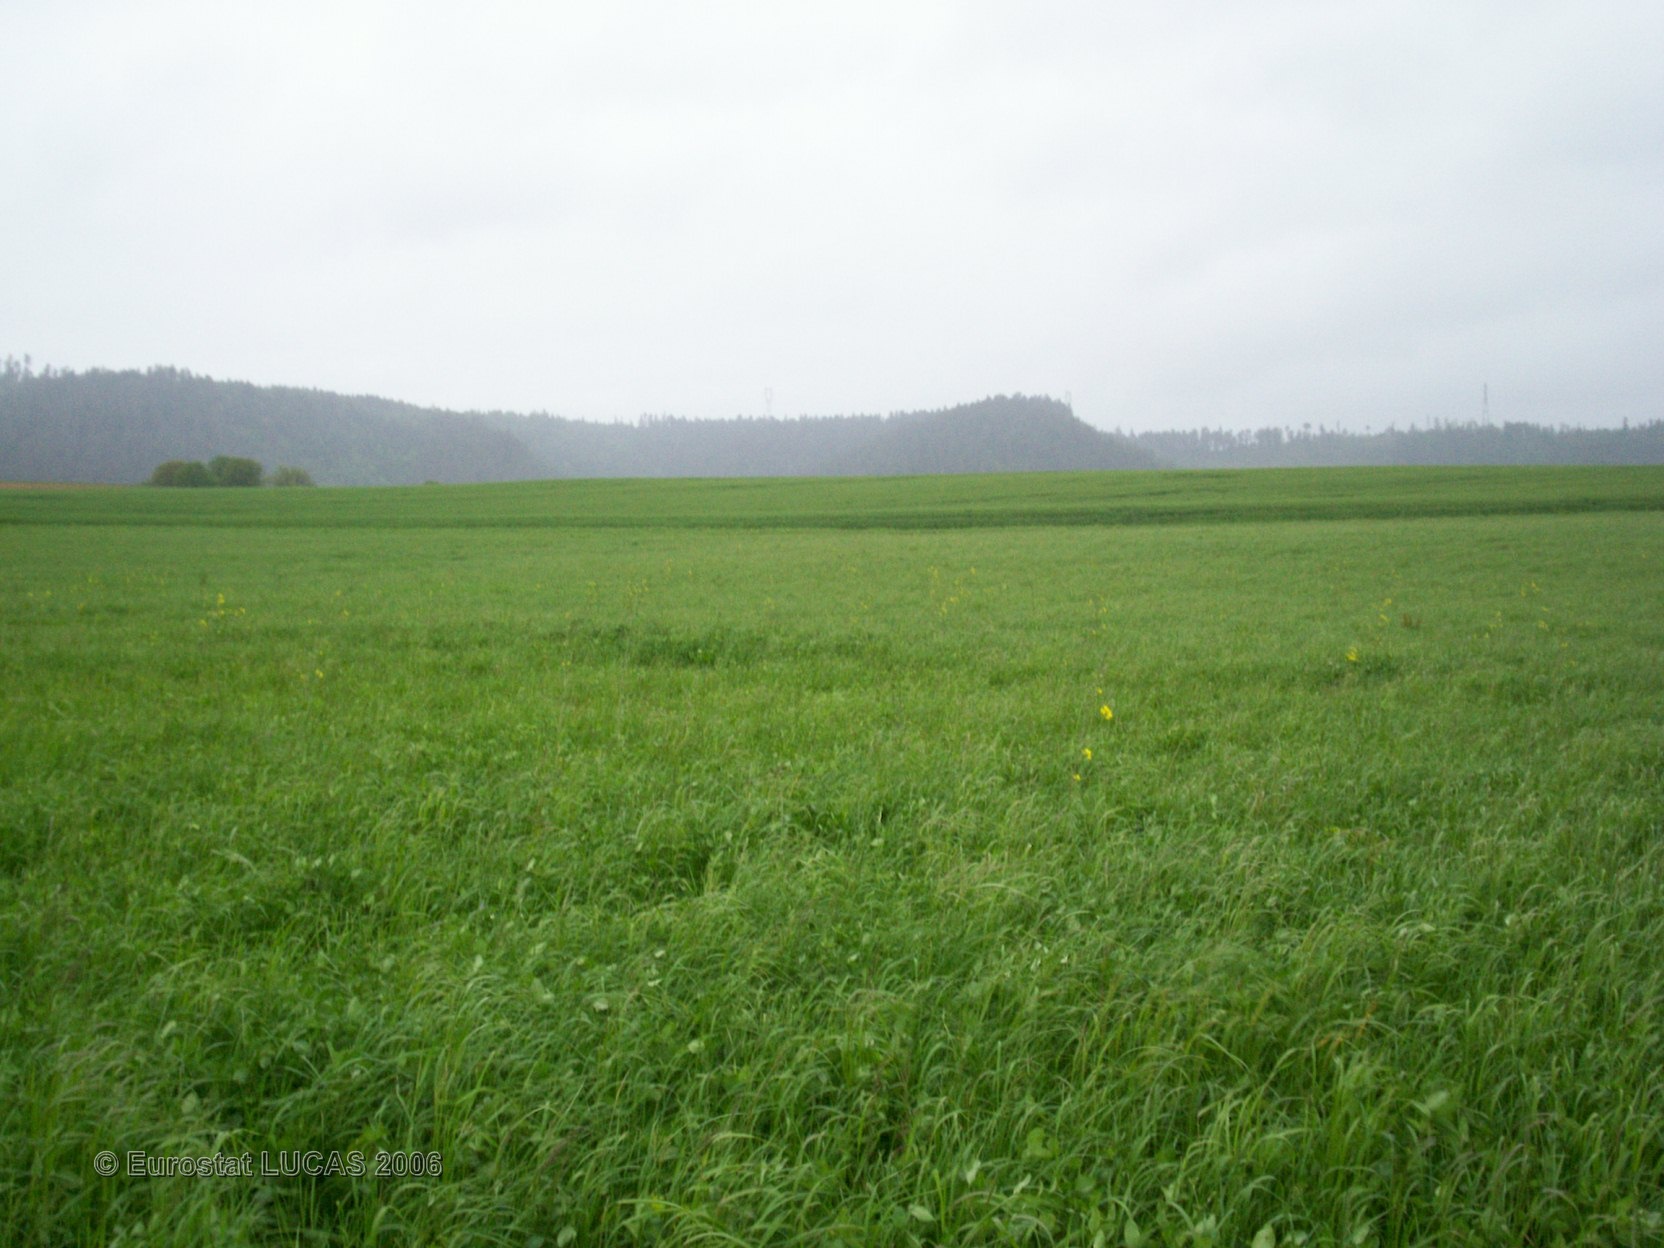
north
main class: Cropland
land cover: Other leguminous and mixtures for fodder
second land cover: Clovers
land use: Agriculture (excluding fallow land and kitchen gardens)
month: May
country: FR
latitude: 48.1947
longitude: 6.7856
